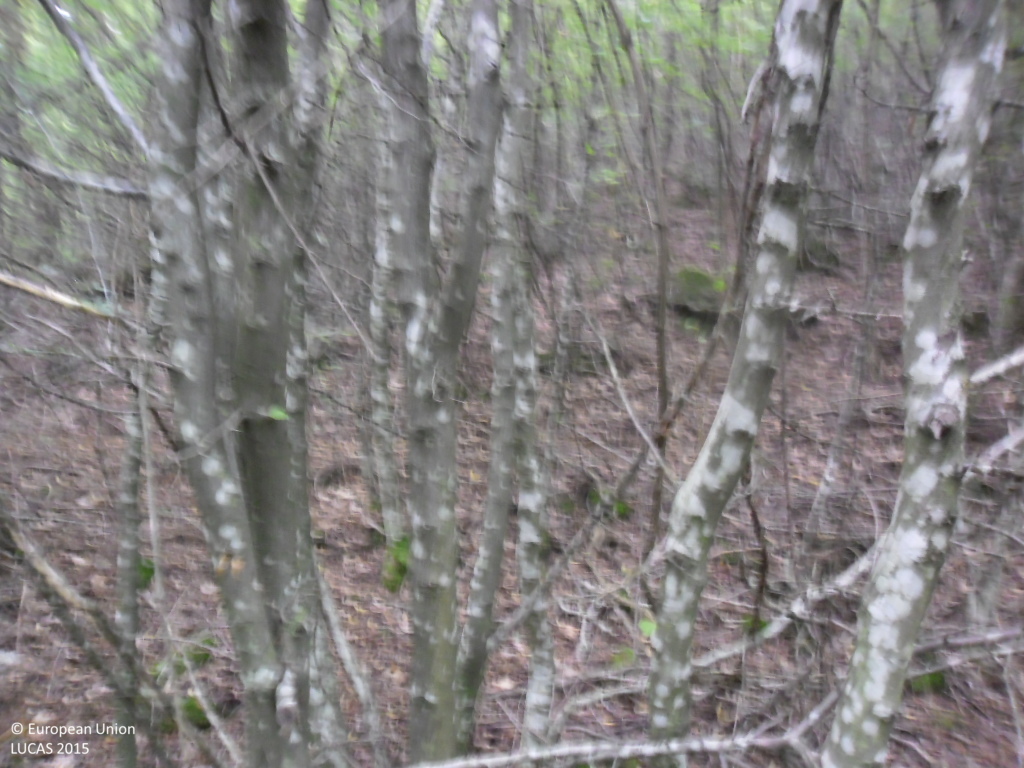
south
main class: Woodland
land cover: Broadleaved woodland
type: mesophytic deciduous forest
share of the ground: > 75 %
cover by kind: broadleaved forest trees 95 %, unconsolidated bare surface 5 %
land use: Forestry
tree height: > 5 m
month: September
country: BG
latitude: 41.9741
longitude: 23.0199
